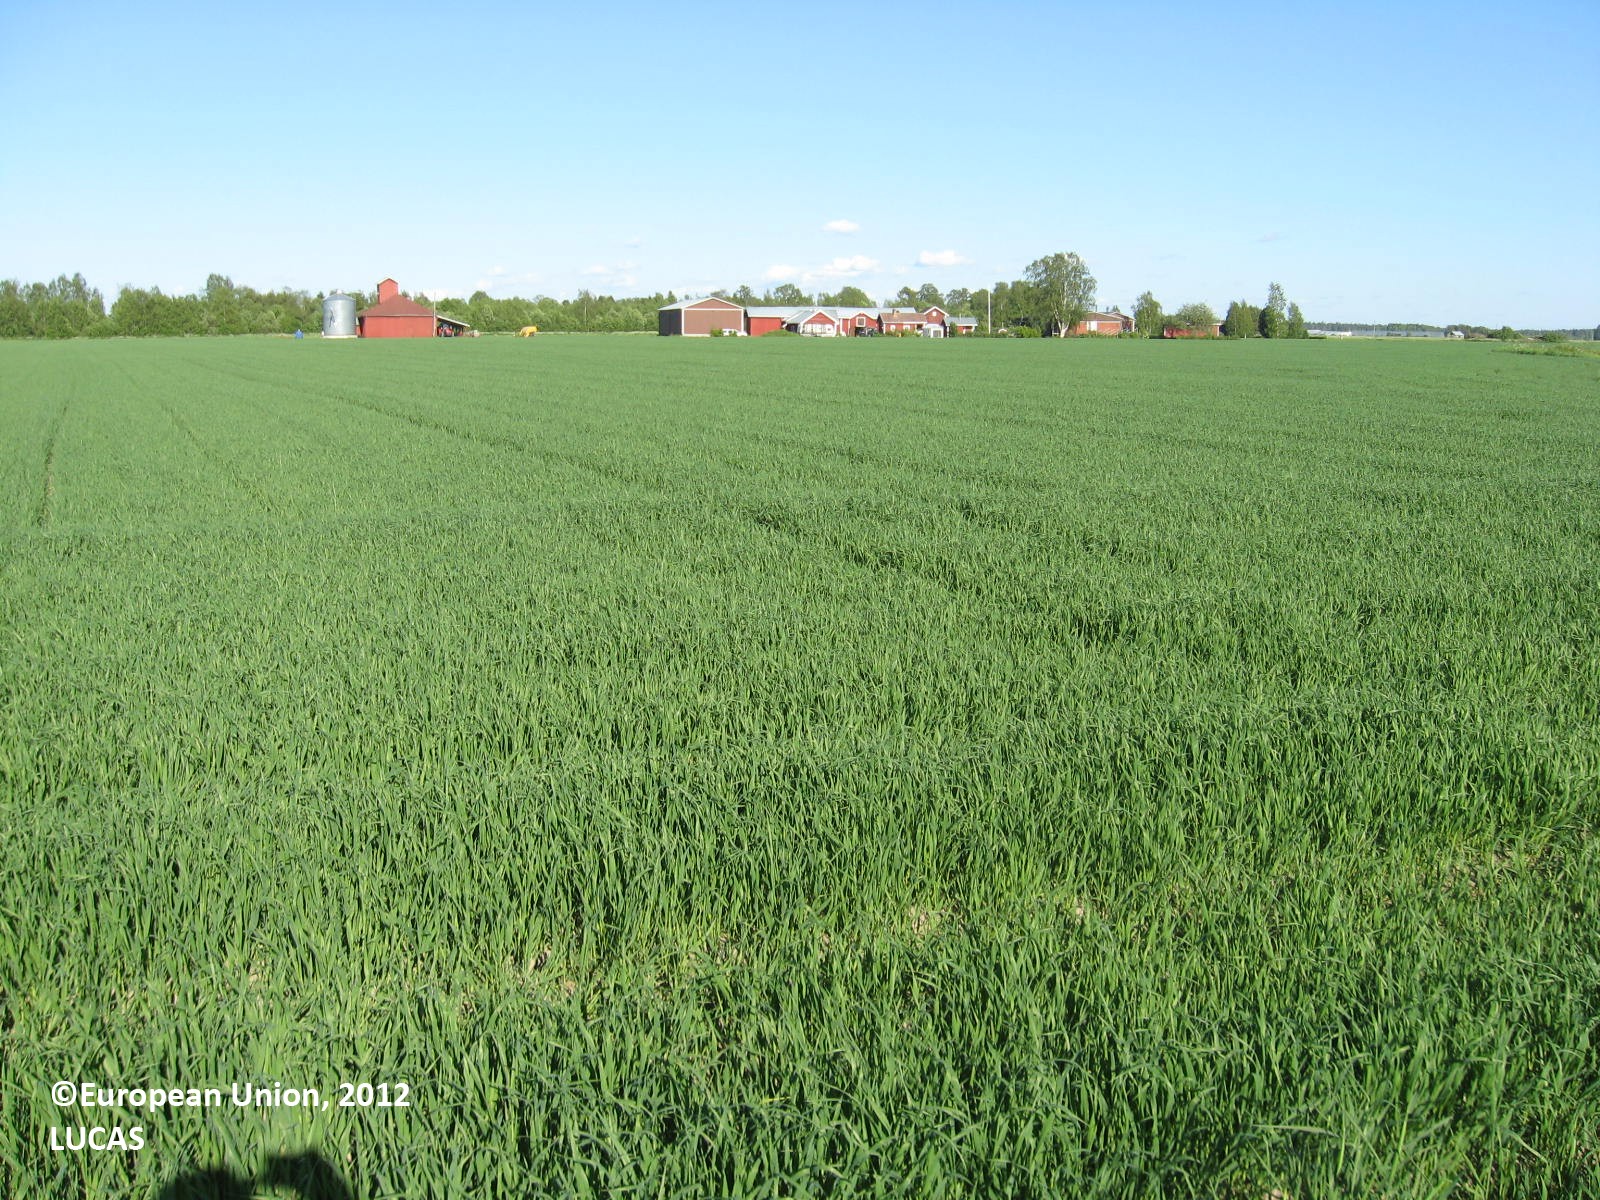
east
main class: Cropland
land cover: Oats
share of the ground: > 75 %
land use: Agriculture (excluding fallow land and kitchen gardens)
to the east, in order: Oats
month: June
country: FI
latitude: 62.9970
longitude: 21.9088
